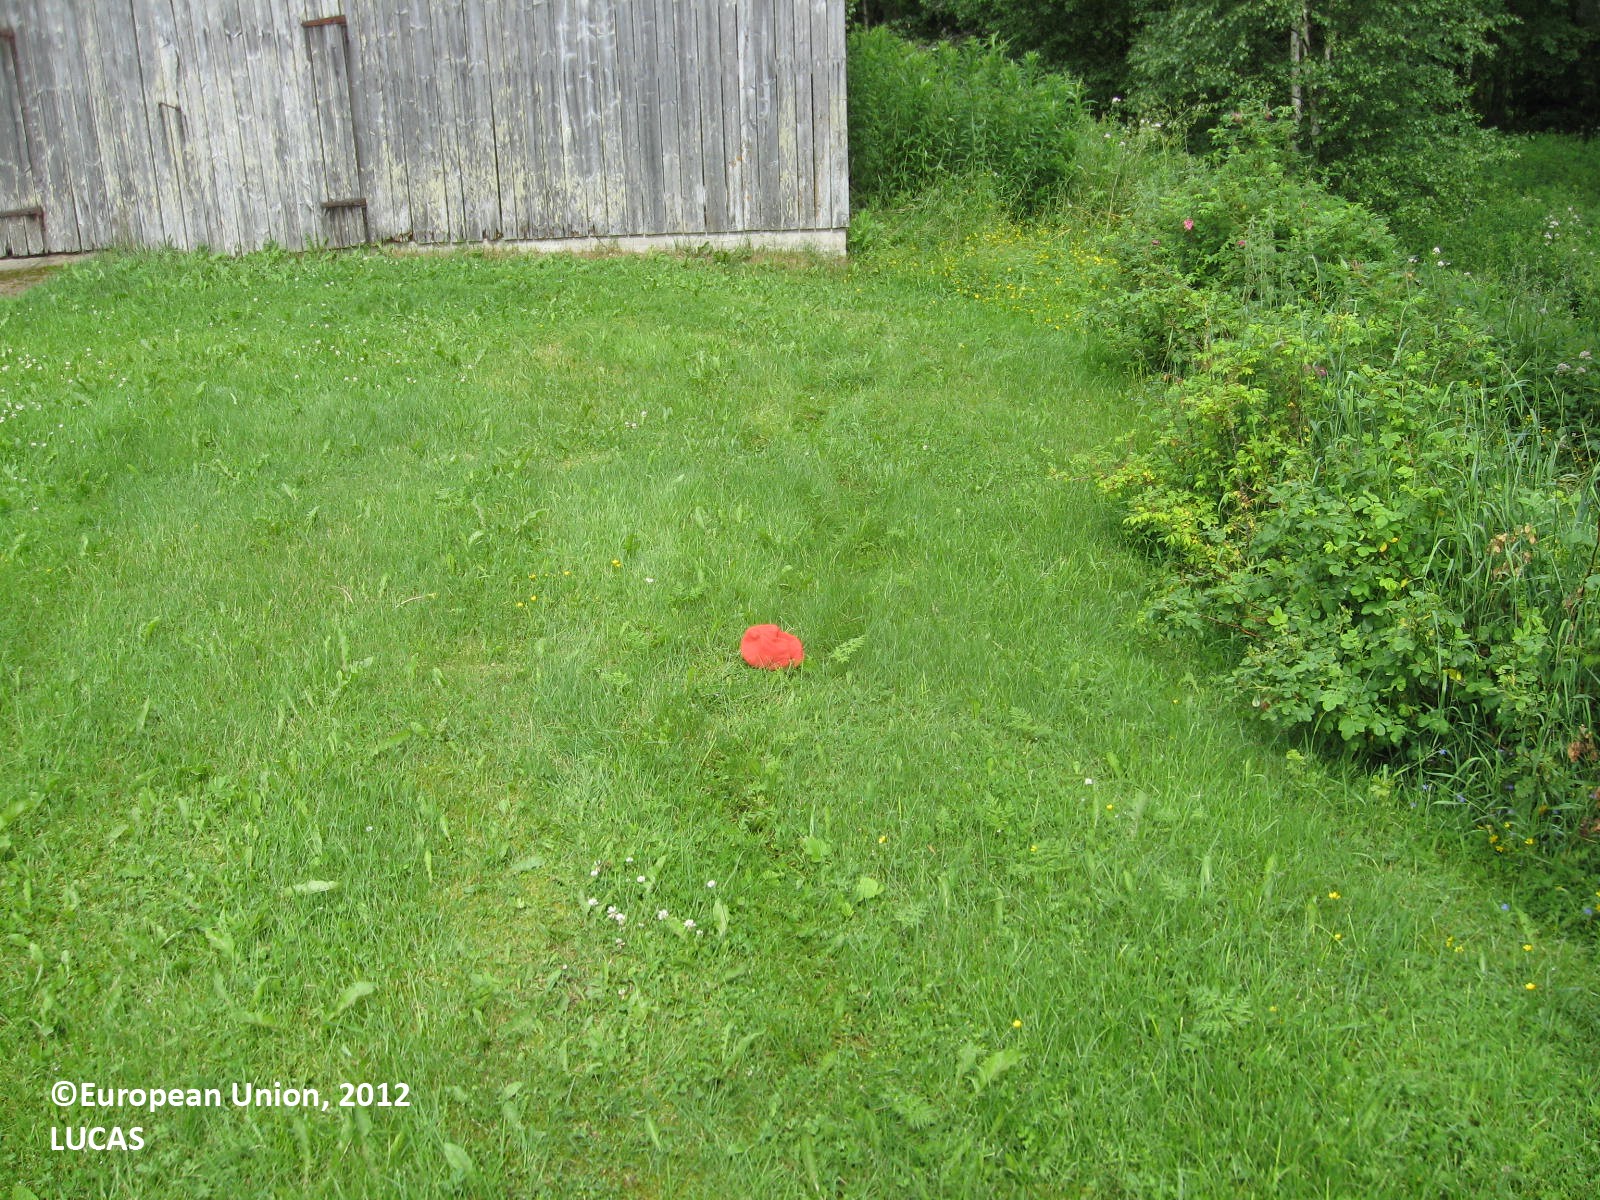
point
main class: Grassland
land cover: Grassland with sparse tree/shrub cover
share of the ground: > 75 %
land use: Residential
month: July
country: FI
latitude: 62.4212
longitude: 22.4666
